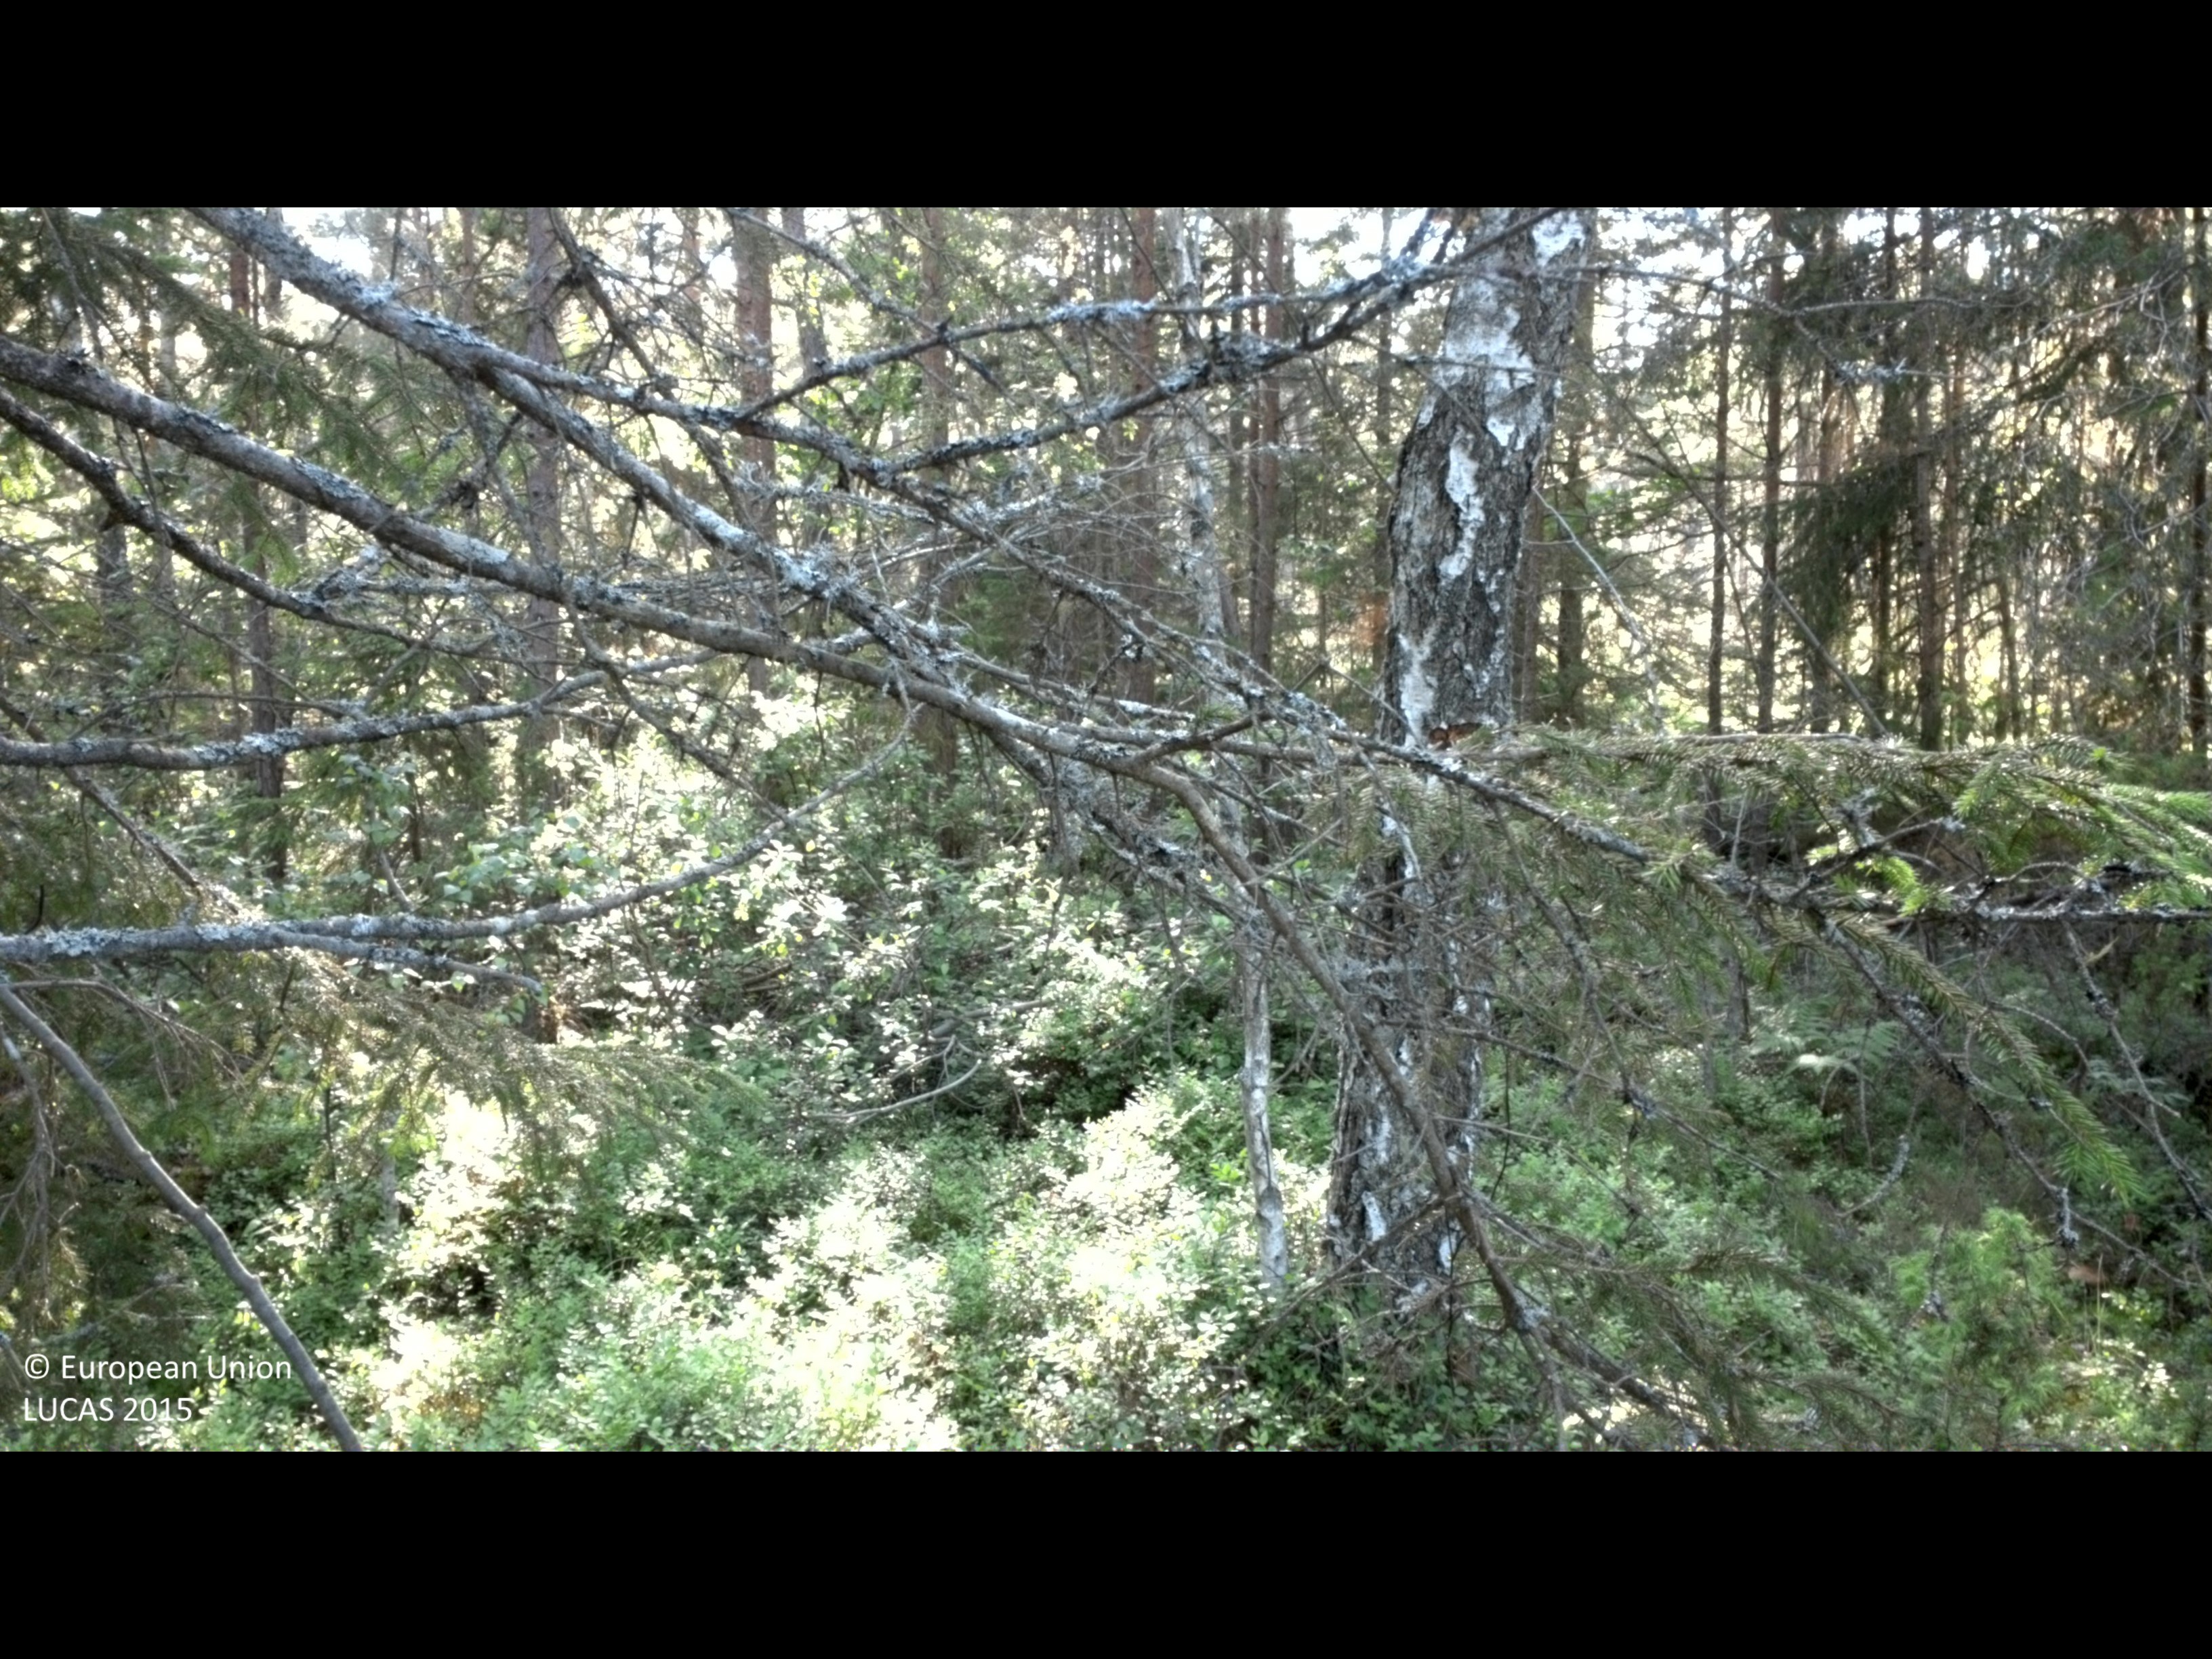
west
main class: Woodland
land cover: Pine dominated coniferous woodland
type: boreal forest
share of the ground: > 75 %
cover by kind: coniferous forest trees 65 %, broadleaved forest trees 15 %, shrubs 15 %, lichens and mosses 5 %
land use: Forestry
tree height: > 5 m
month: June
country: SE
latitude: 58.0171
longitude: 16.6845
